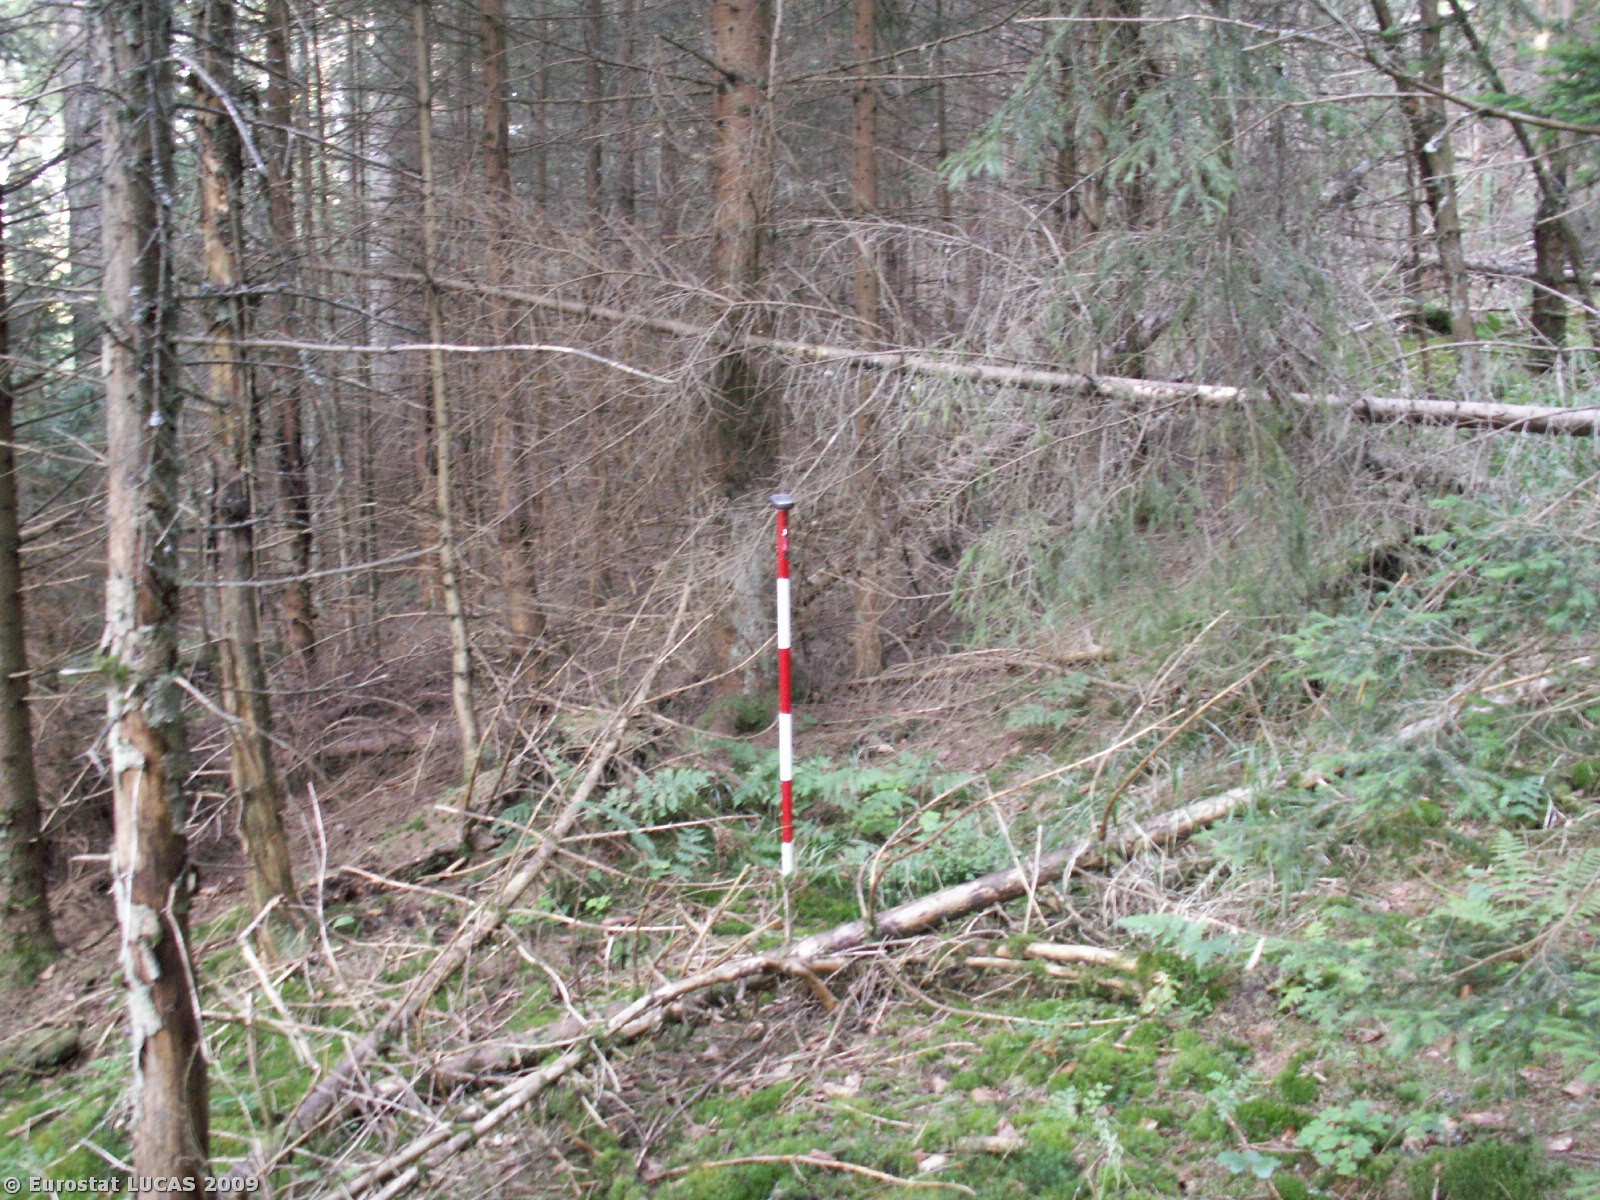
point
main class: Woodland
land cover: Coniferous woodland
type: hemiboreal forest and nemoral coniferous forest and mixed broadleaved-coniferous forest
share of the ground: > 75 %
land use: Forestry
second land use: Nature reserves
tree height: > 5 m
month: July
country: CZ
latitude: 48.8415
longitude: 13.8289
